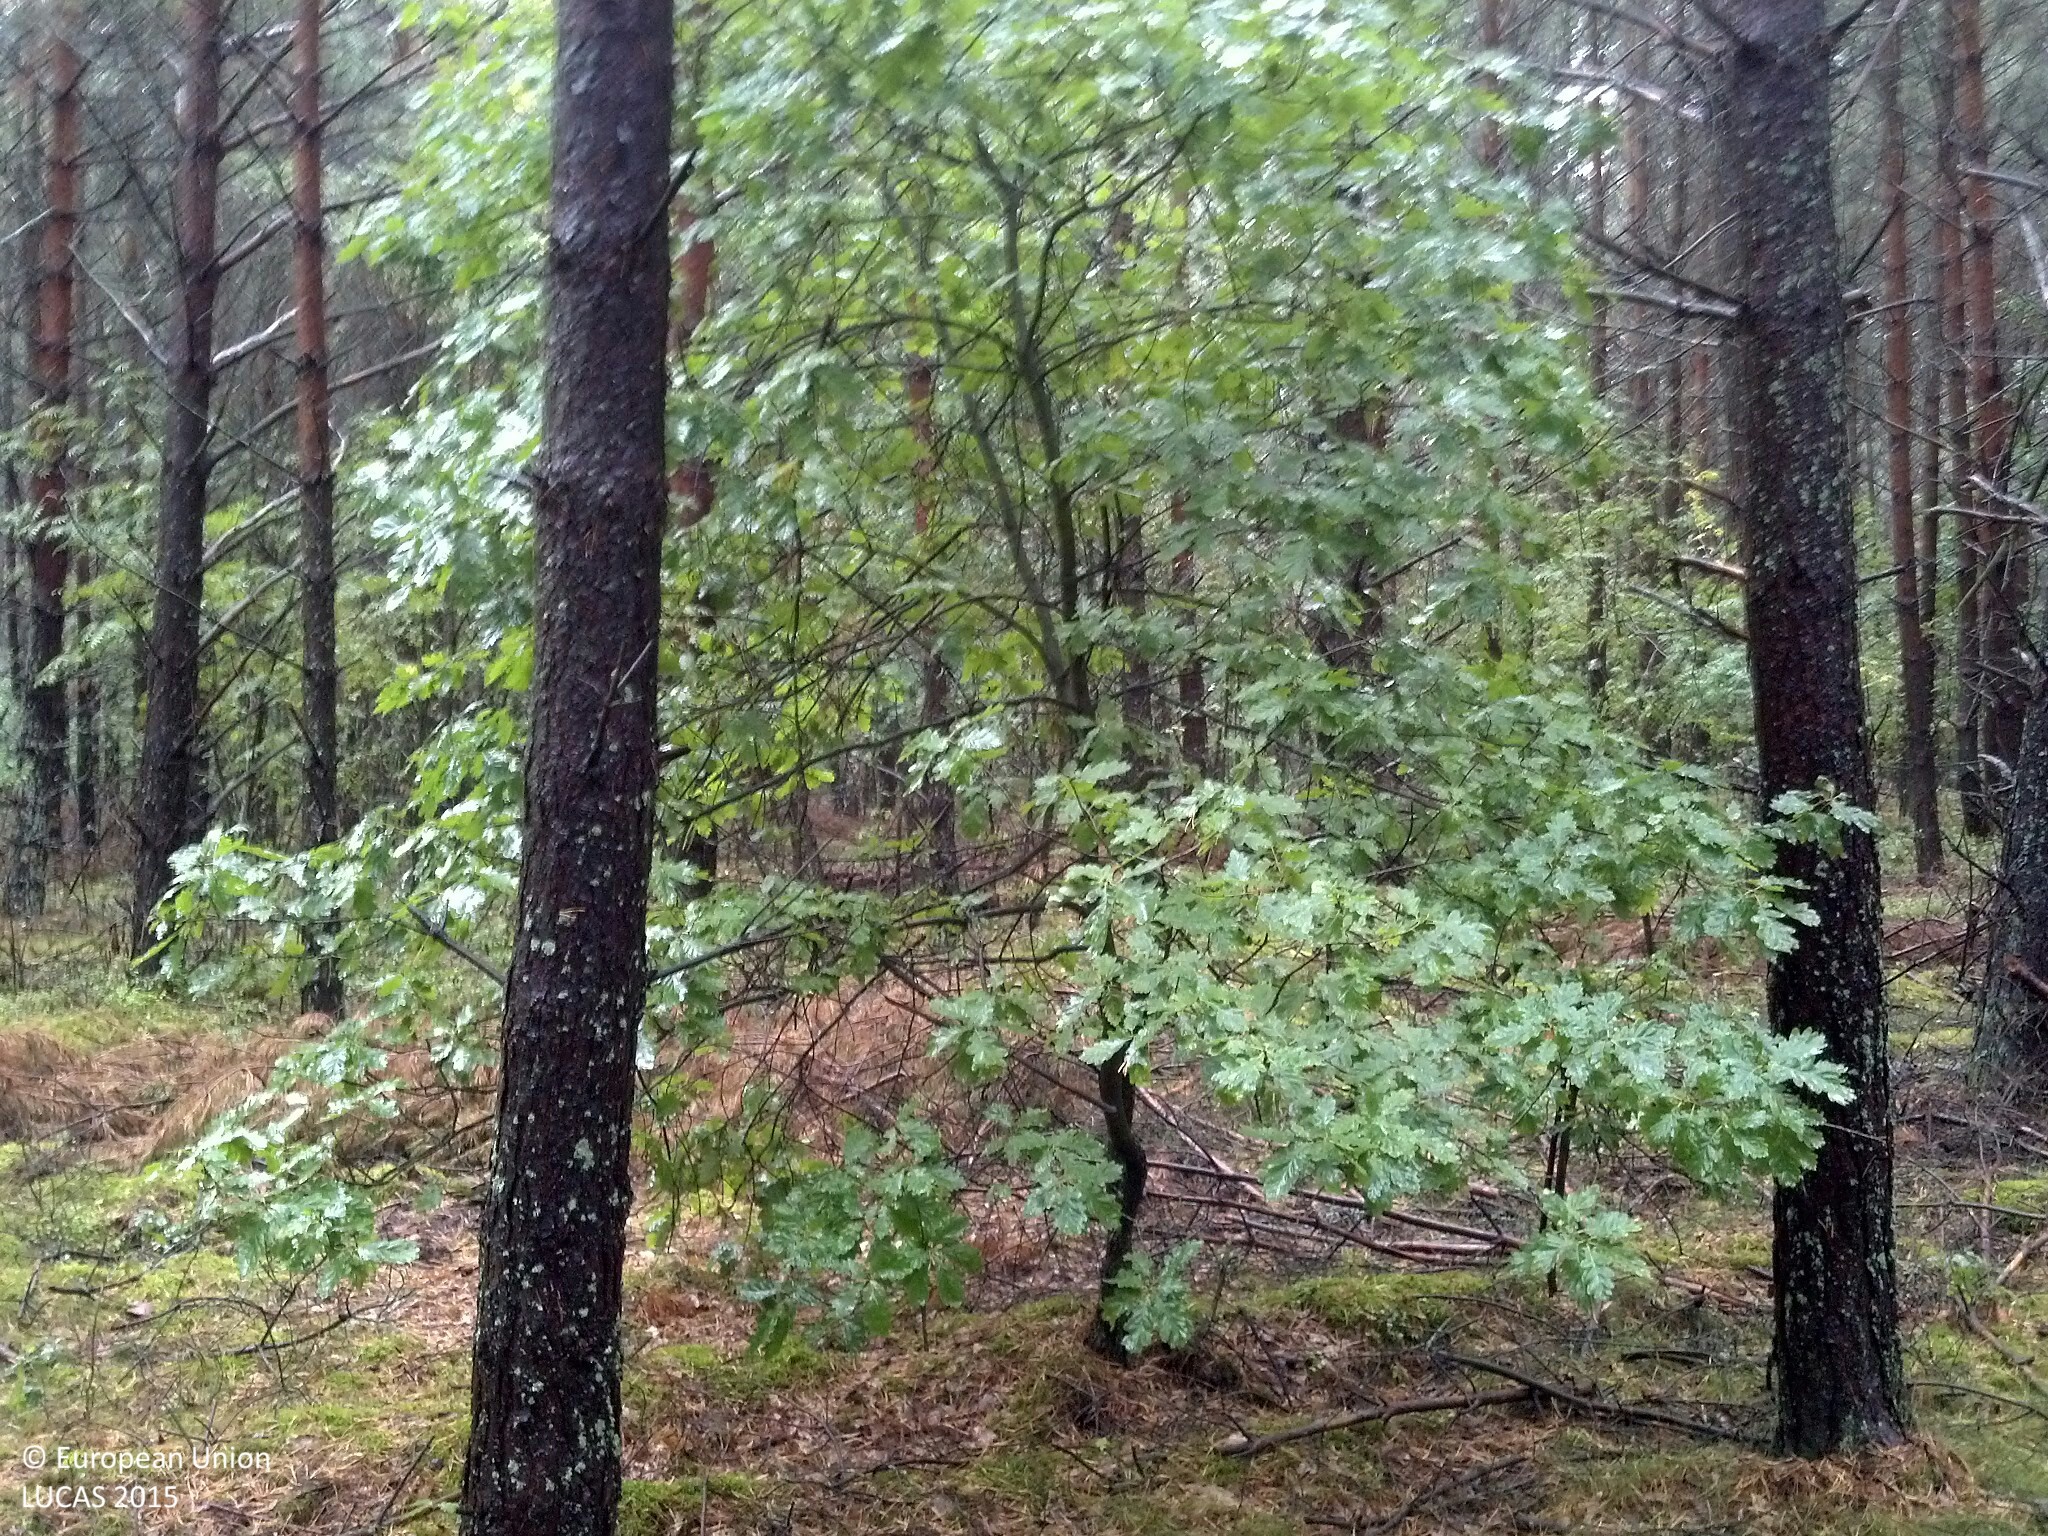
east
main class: Woodland
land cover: Pine dominated coniferous woodland
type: hemiboreal forest and nemoral coniferous forest and mixed broadleaved-coniferous forest
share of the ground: > 75 %
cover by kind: coniferous forest trees 85 %, broadleaved forest trees 5 %, herbaceous plants 5 %, lichens and mosses 5 %
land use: Forestry
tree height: > 5 m
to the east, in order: Pine dominated coniferous woodland; Tracks; Pine dominated coniferous woodland; Inland marshes; Inland fresh water bodies
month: September
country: PL
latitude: 54.5341
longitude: 17.9099
